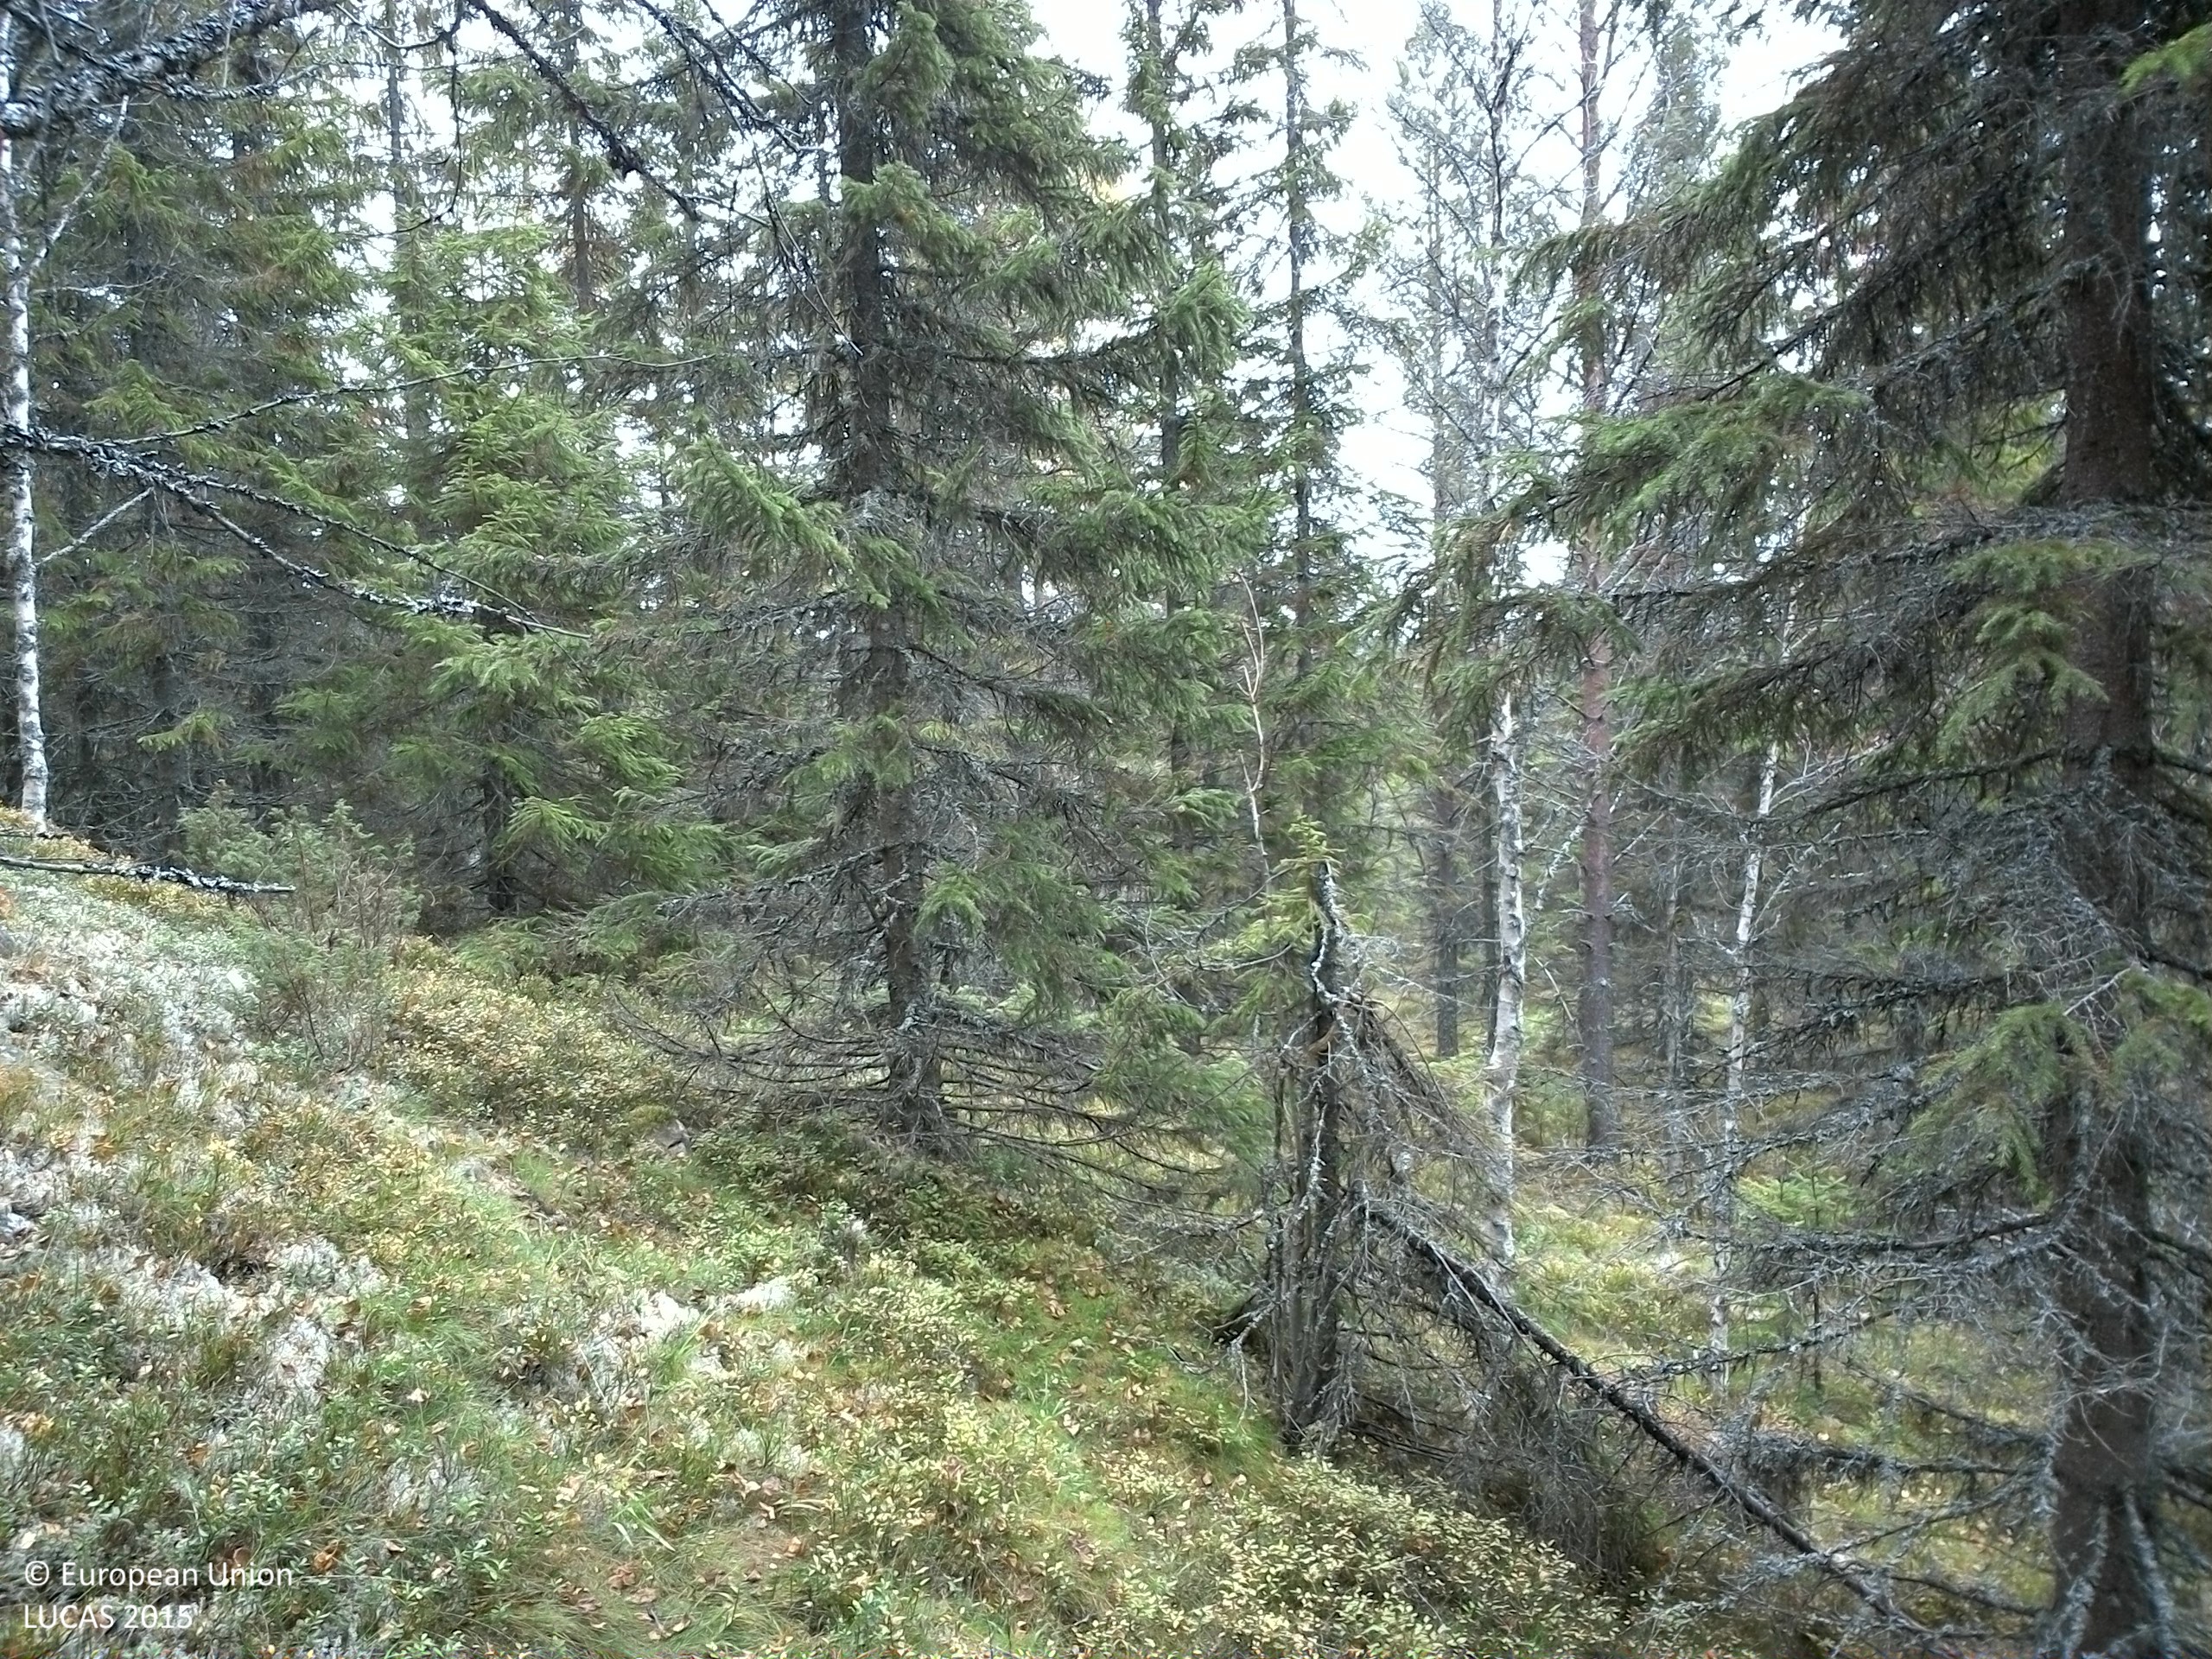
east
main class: Woodland
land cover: Spruce dominated mixed woodland
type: boreal forest
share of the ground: 50 - 75 %
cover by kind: coniferous forest trees 50 %, shrubs 30 %, broadleaved forest trees 20 %
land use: Forestry
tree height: > 5 m
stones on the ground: 10 - 25 %
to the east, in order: Spruce dominated mixed woodland; Shrubland without tree cover; Paved roads, cycling and walking lanes; Shrubland without tree cover; Spruce dominated mixed woodland; Pine dominated mixed woodland; Peatbogs; Inland fresh water bodies; Peatbogs; Pine dominated mixed woodland
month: October
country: SE
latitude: 61.4662
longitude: 14.3580
